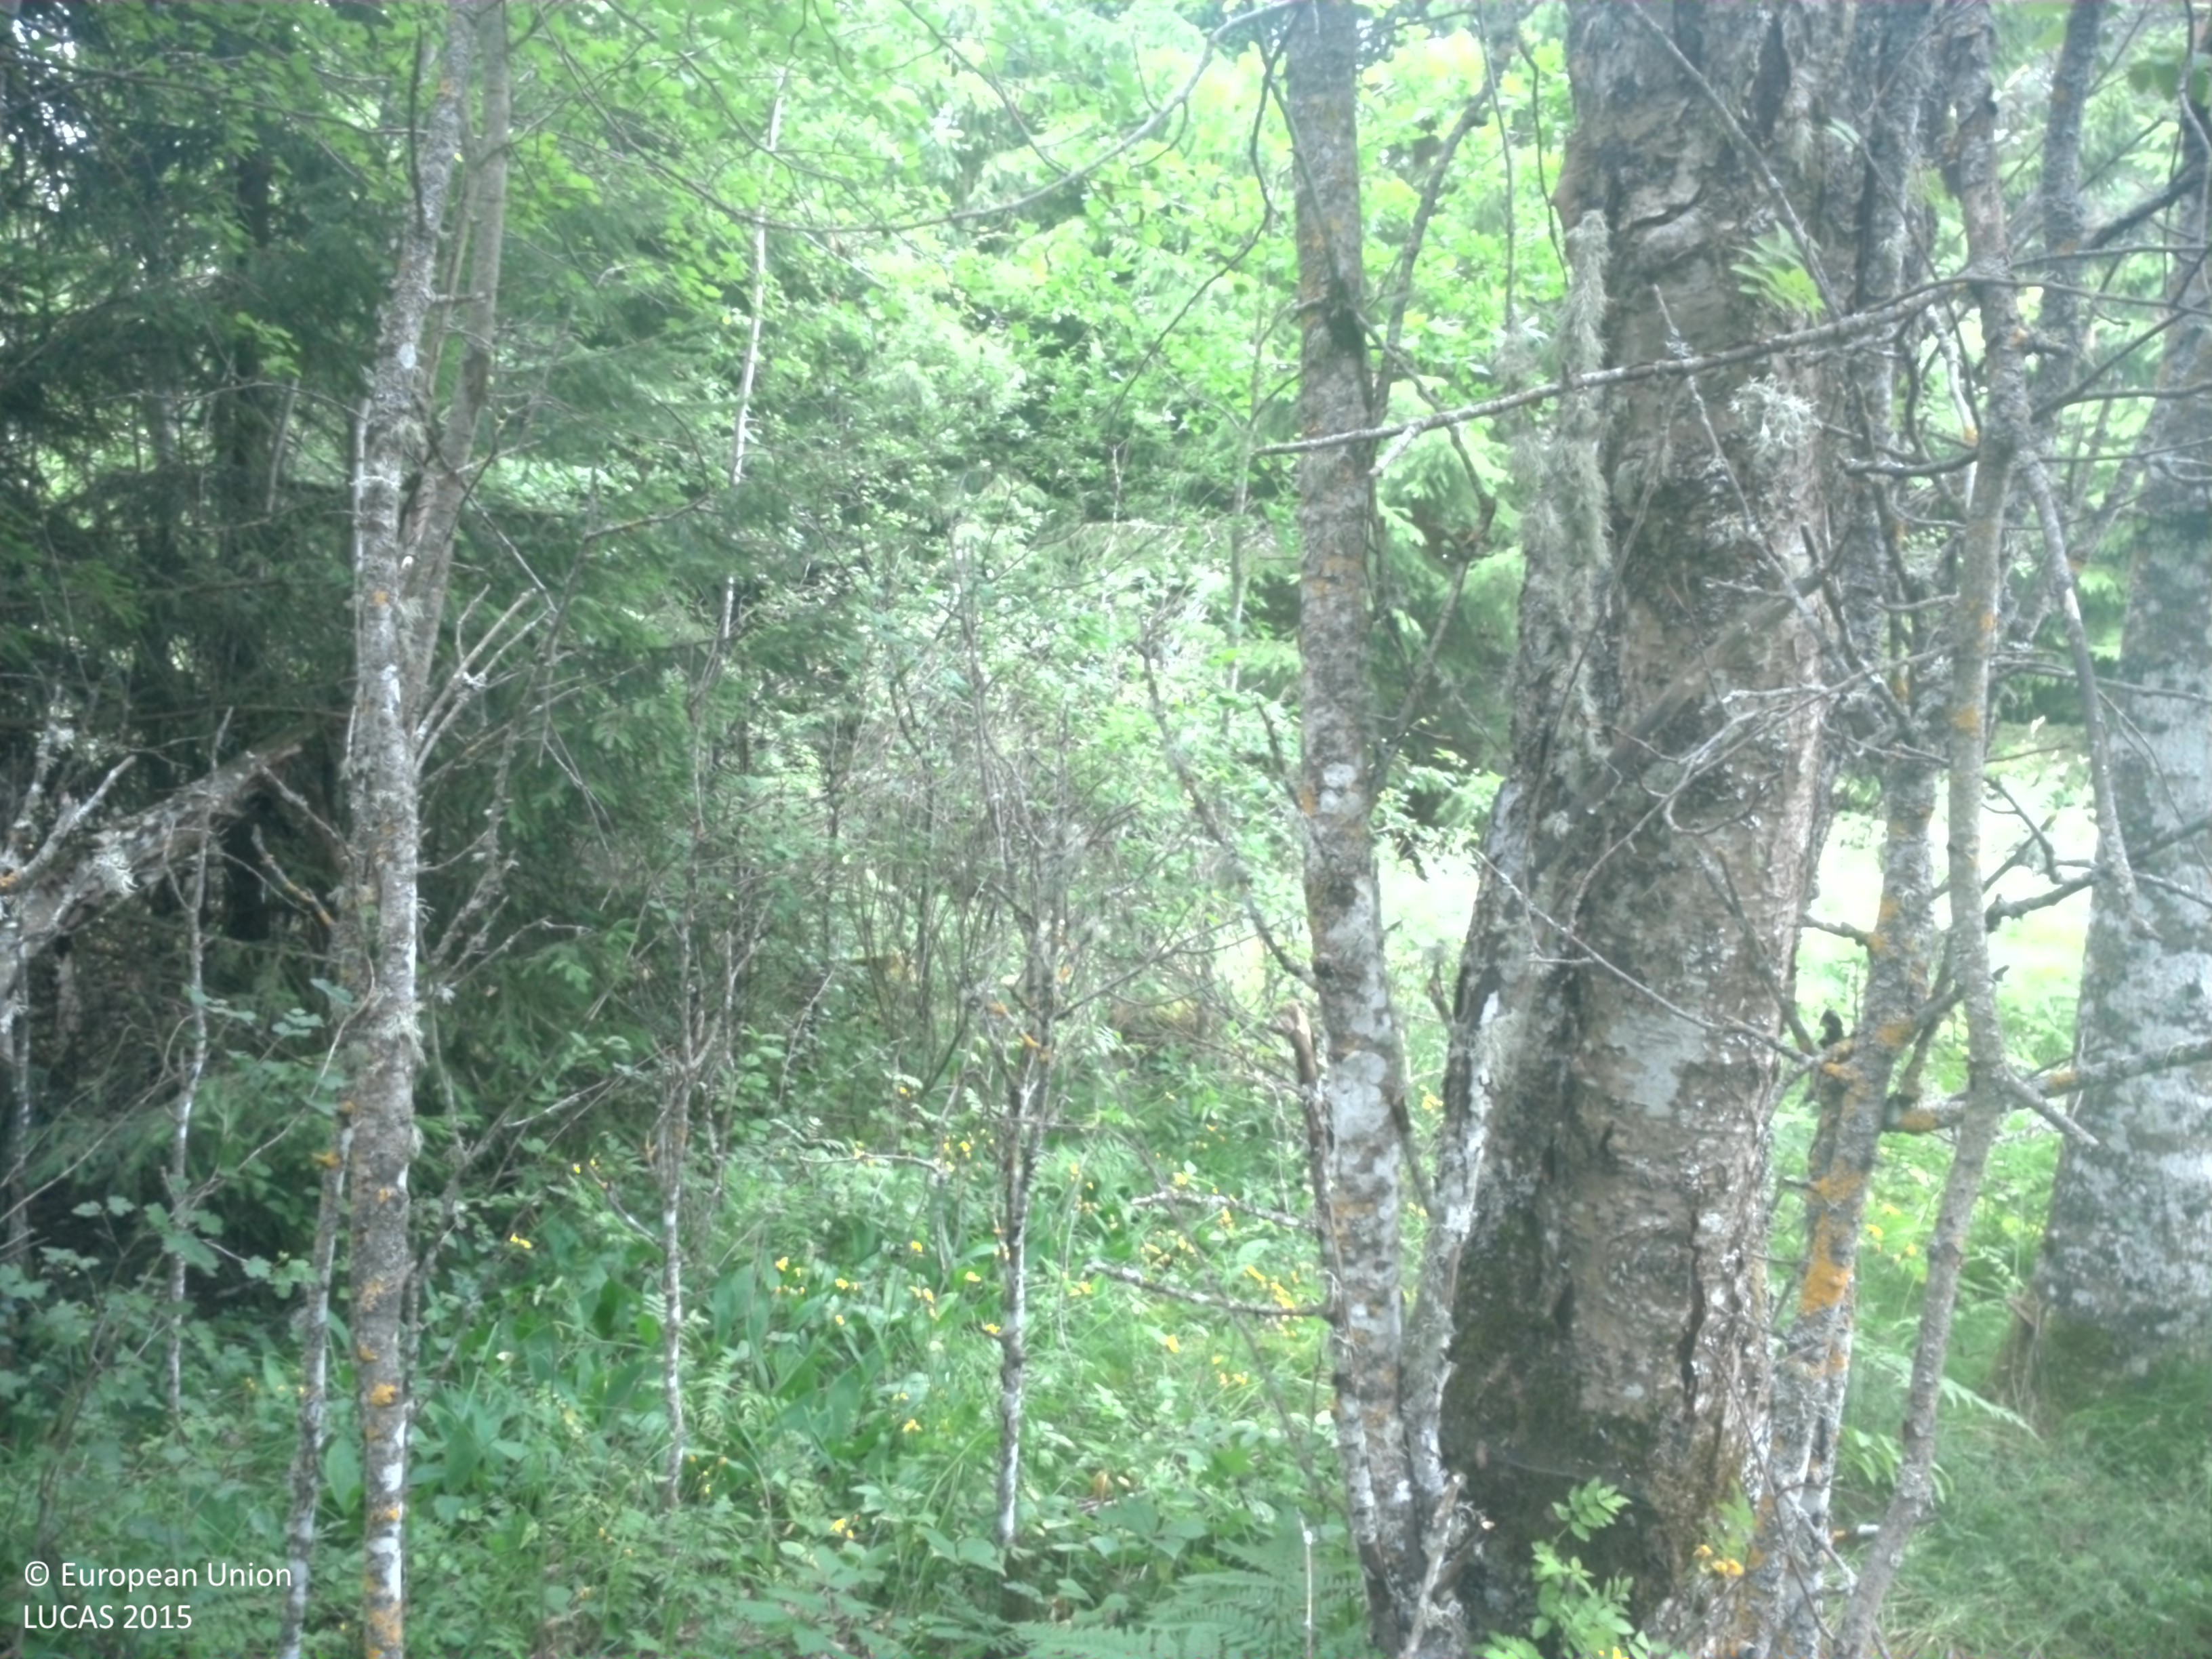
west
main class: Woodland
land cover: Broadleaved woodland
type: boreal forest
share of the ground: > 75 %
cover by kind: broadleaved forest trees 65 %, coniferous forest trees 20 %, herbaceous plants 15 %
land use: Forestry
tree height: > 5 m
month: July
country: SE
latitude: 59.7645
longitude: 17.4896
